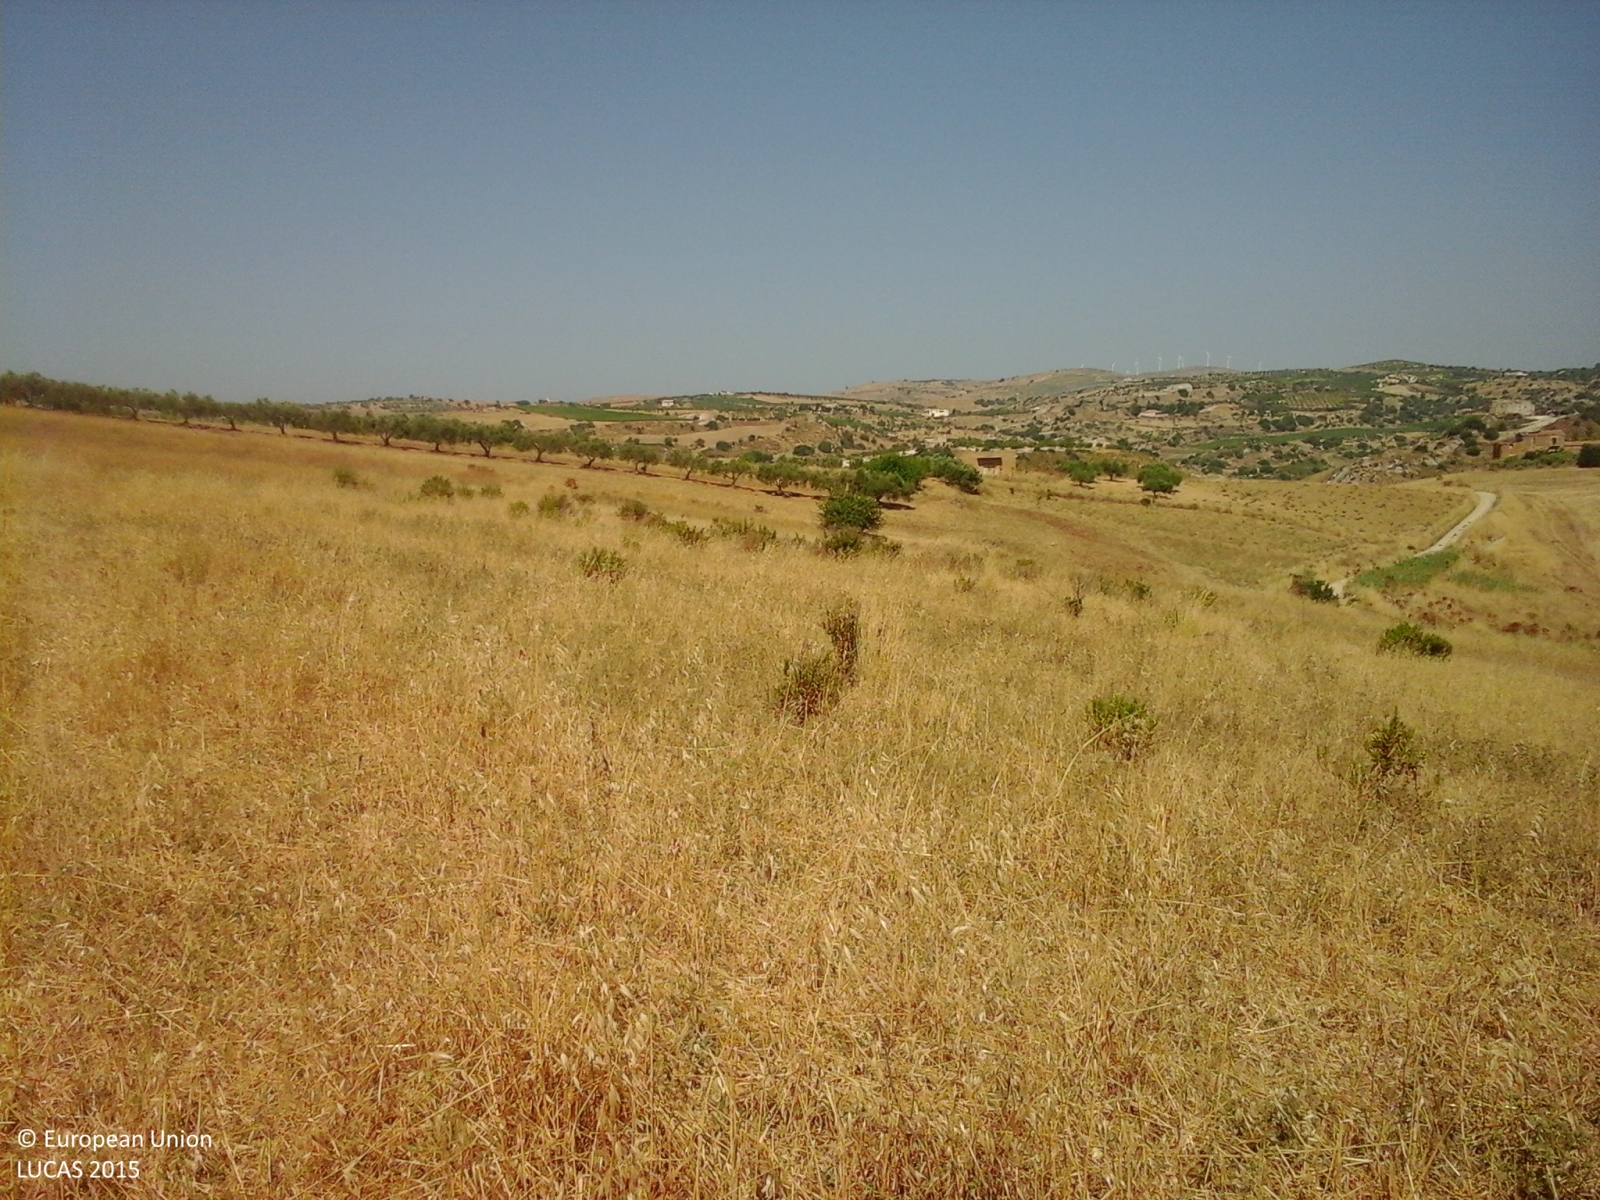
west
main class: Grassland
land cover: Spontaneously vegetated surfaces
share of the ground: > 75 %
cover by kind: herbaceous plants 100 %
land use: Fallow land
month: July
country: IT
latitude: 37.3187
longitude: 13.5270
